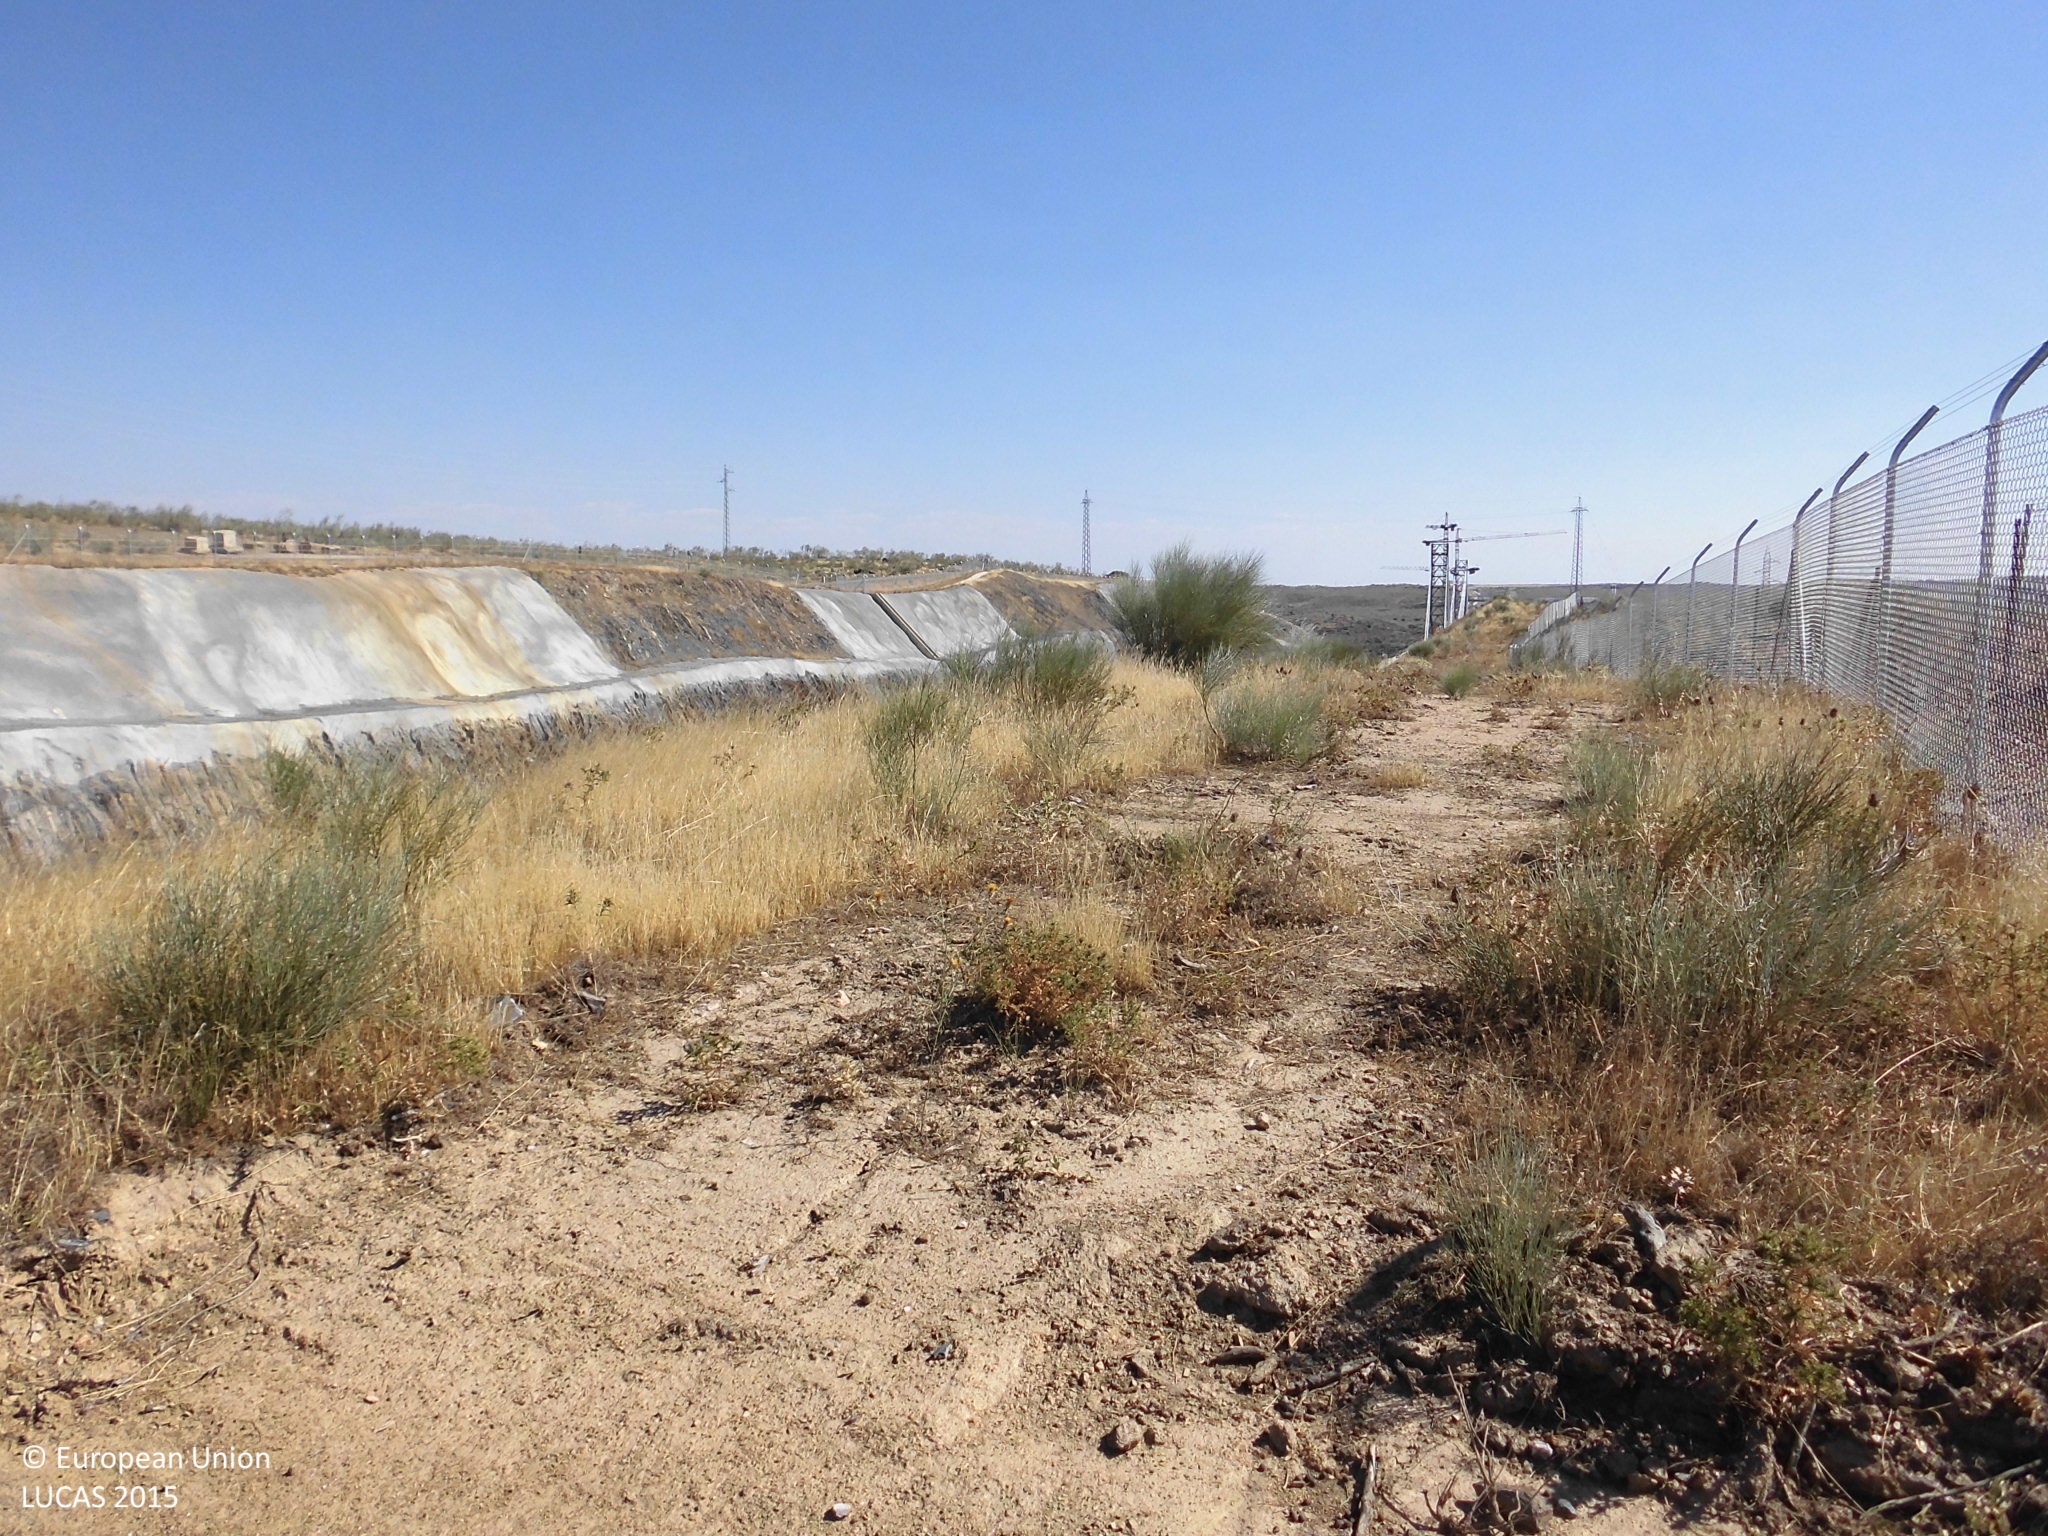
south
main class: Shrubland
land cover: Shrubland with sparse tree cover
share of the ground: 10 - 25 %
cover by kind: herbaceous plants 80 %, shrubs 15 %, broadleaved forest trees 5 %
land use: Forestry
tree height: > 5 m
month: June
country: ES
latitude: 39.6955
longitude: -6.4581
